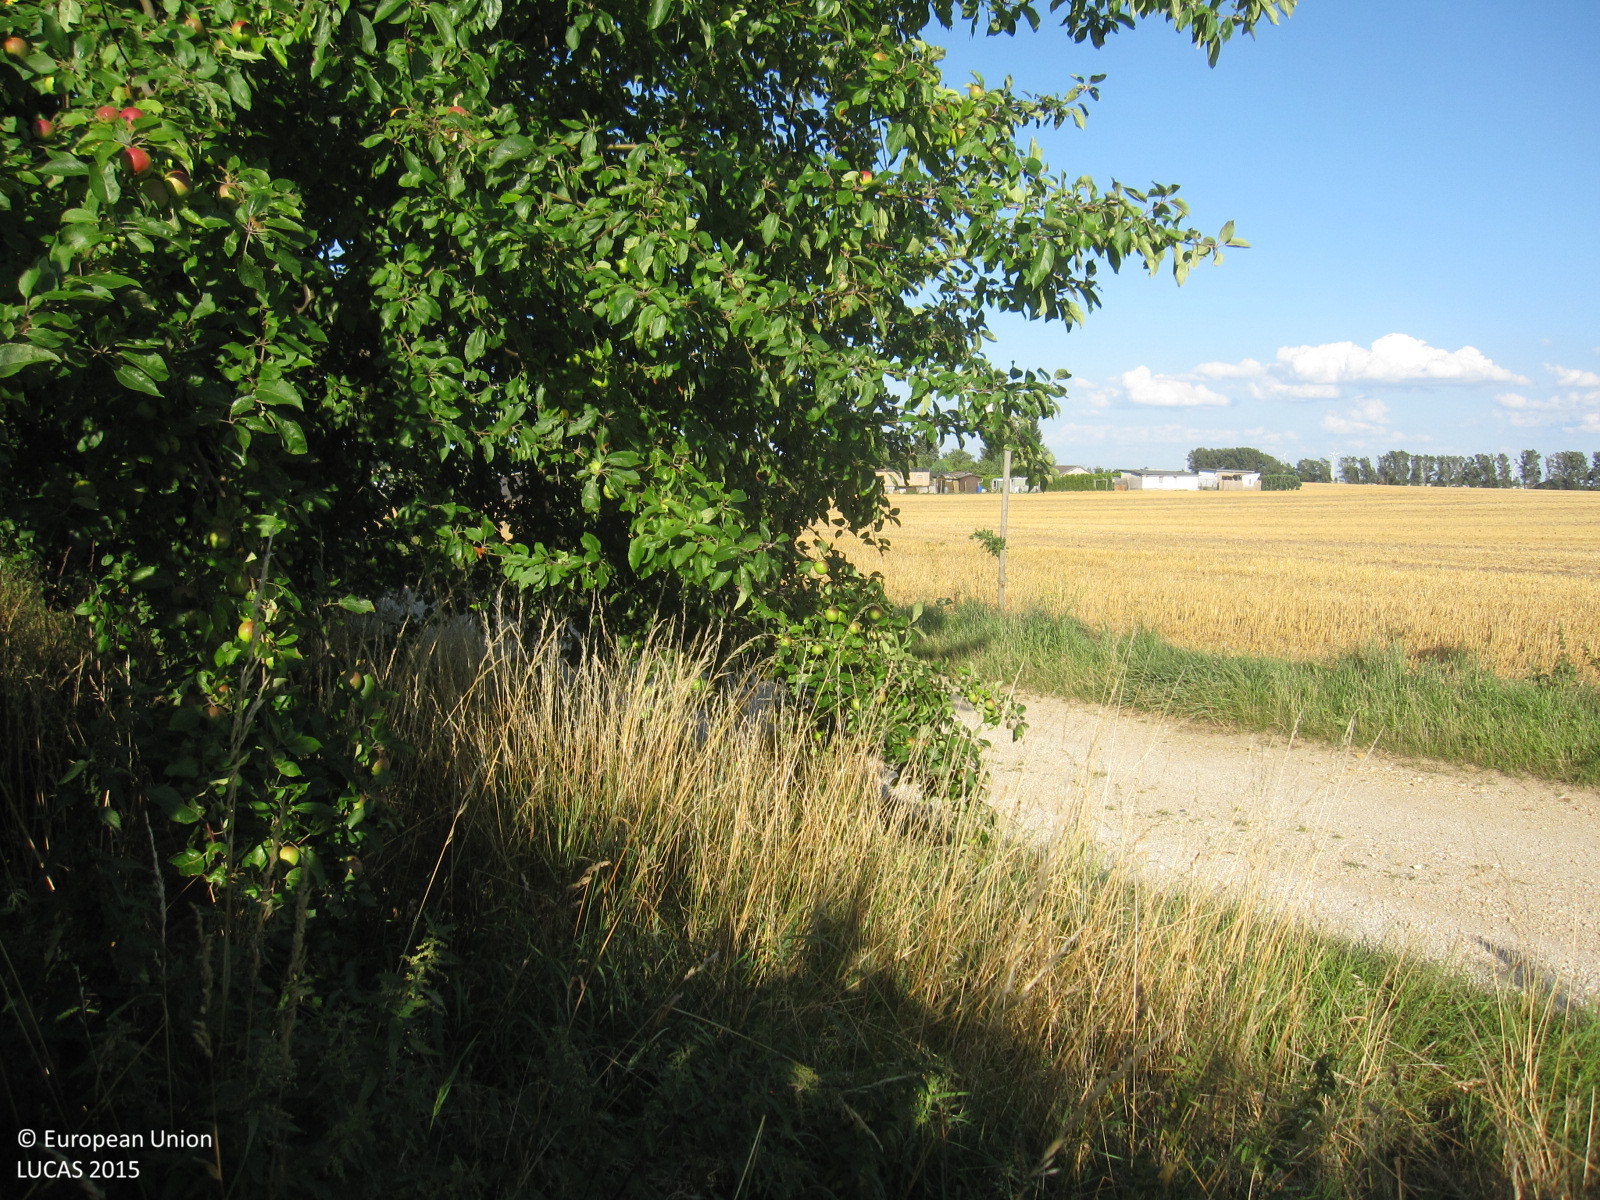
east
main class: Cropland
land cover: Maize
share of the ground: > 75 %
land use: Agriculture (excluding fallow land and kitchen gardens)
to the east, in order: Maize; Lines of trees; Grass margins; Tracks; Grass margins; Lines of trees; Barley; Artificial constructions in urban areas
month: July
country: DE
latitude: 51.0088
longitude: 12.1803
